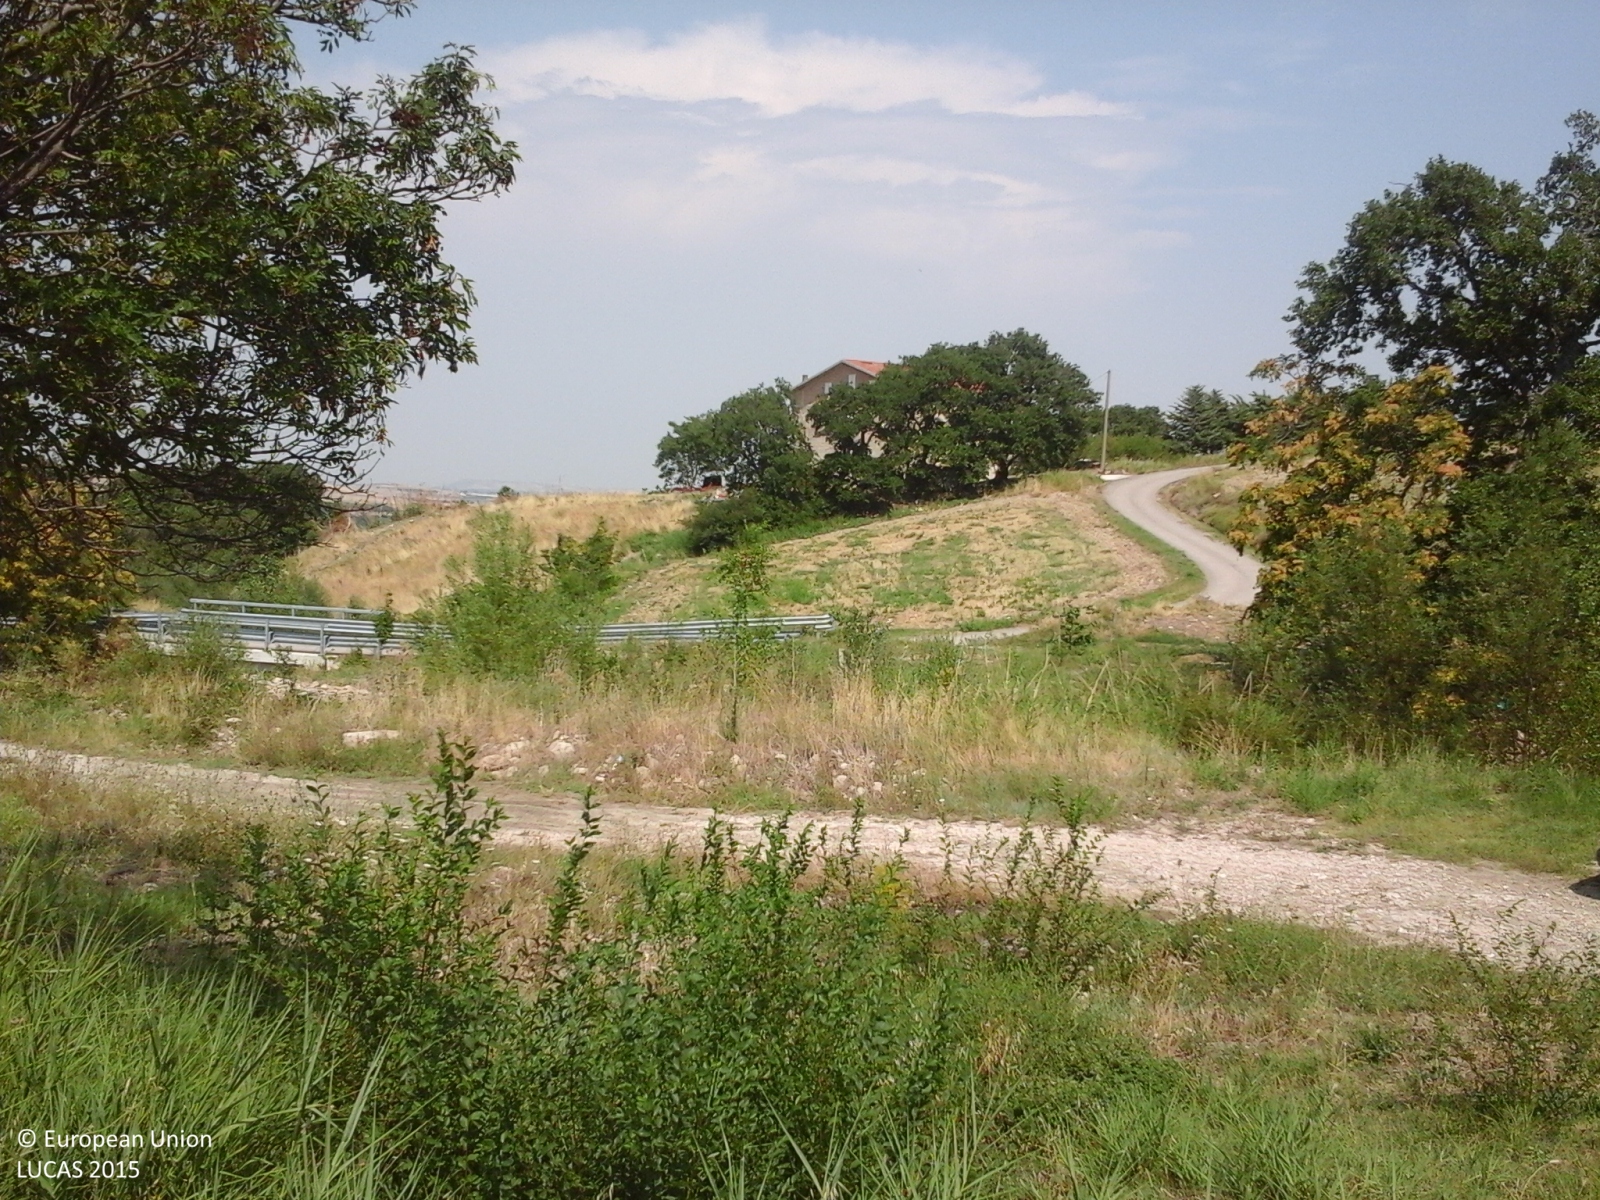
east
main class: Cropland
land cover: Olive groves
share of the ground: 50 - 75 %
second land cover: Spontaneously vegetated surfaces
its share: > 75 %
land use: Agriculture (excluding fallow land and kitchen gardens)
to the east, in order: Olive groves; Spontaneously vegetated surfaces; Artificial constructions in urban areas; Olive groves; Electric lines; Olive groves; Grass margins; Paved roads, cycling and walking lanes; Shrubland without tree cover; Artificial constructions; Single bushes/trees; Ditches and canals; Artificial constructions; Shrubland without tree cover; Grassland with sparse tree/shrub cover; Artificial constructions in urban areas
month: August
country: IT
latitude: 41.3988
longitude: 15.1851
